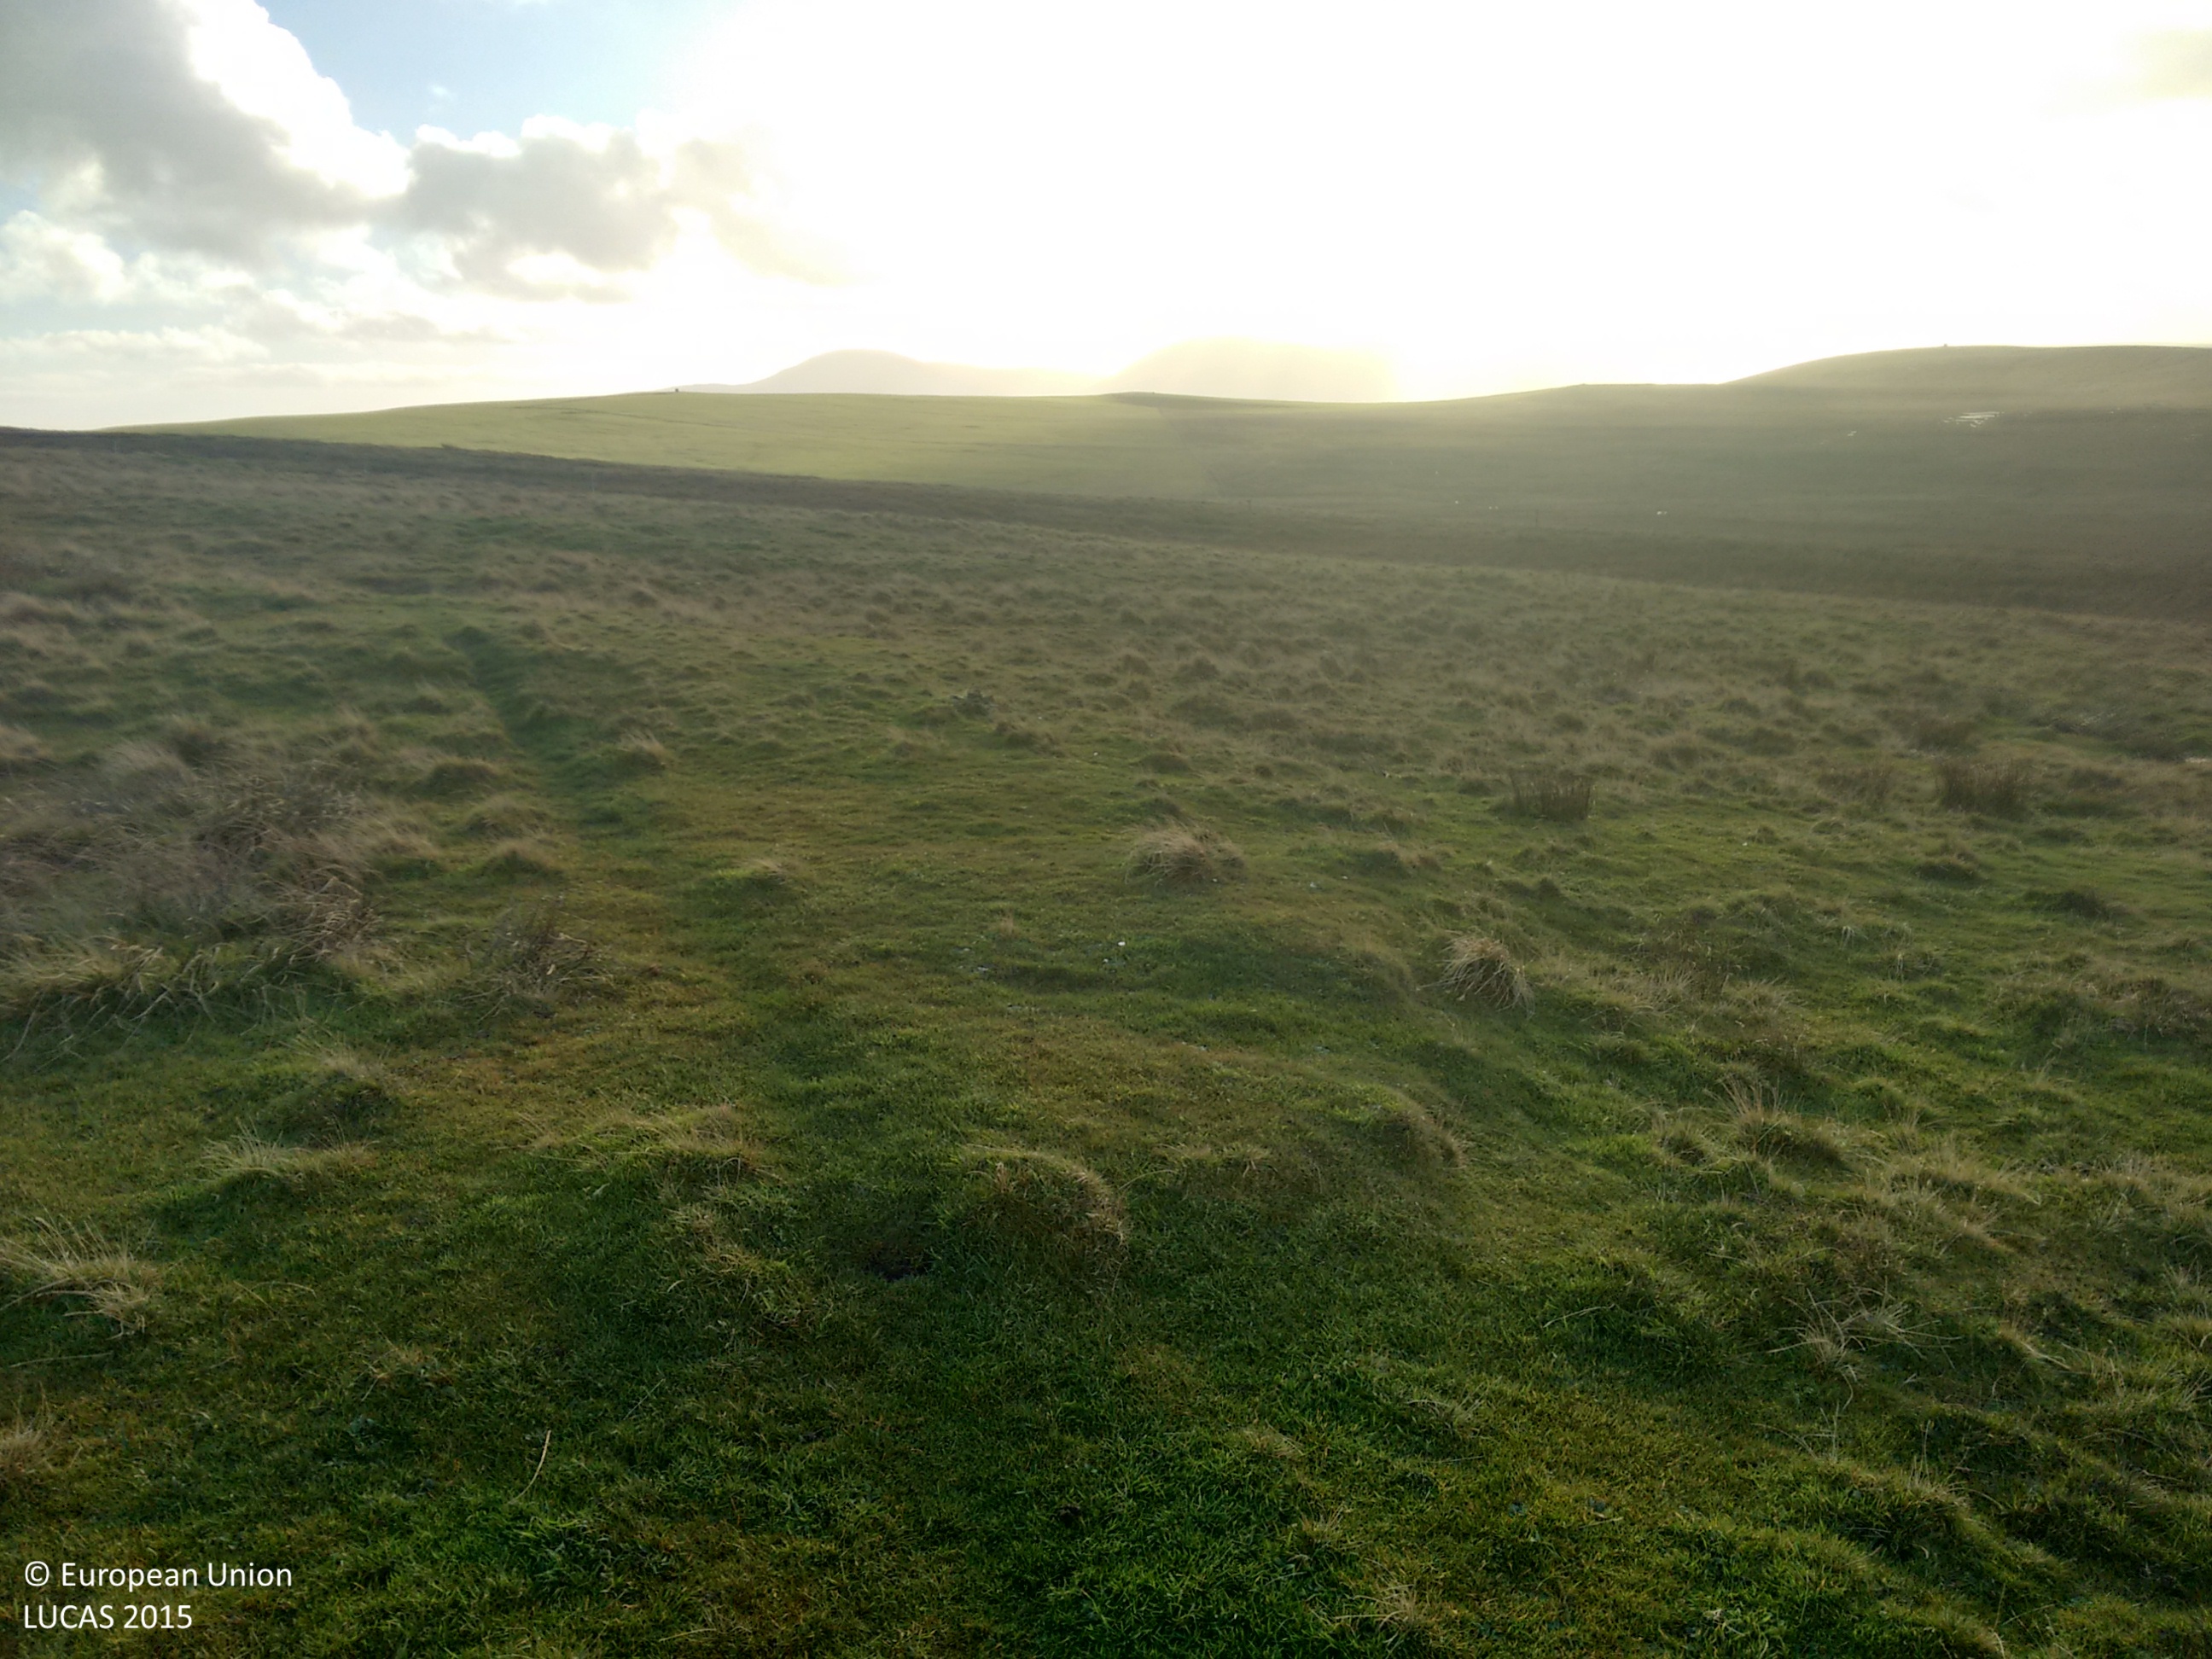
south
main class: Grassland
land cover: Grassland without tree/shrub cover
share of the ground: > 75 %
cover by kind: herbaceous plants 100 %
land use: Agriculture (excluding fallow land and kitchen gardens)
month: November
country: GB
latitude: 58.9946
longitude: -3.3382
